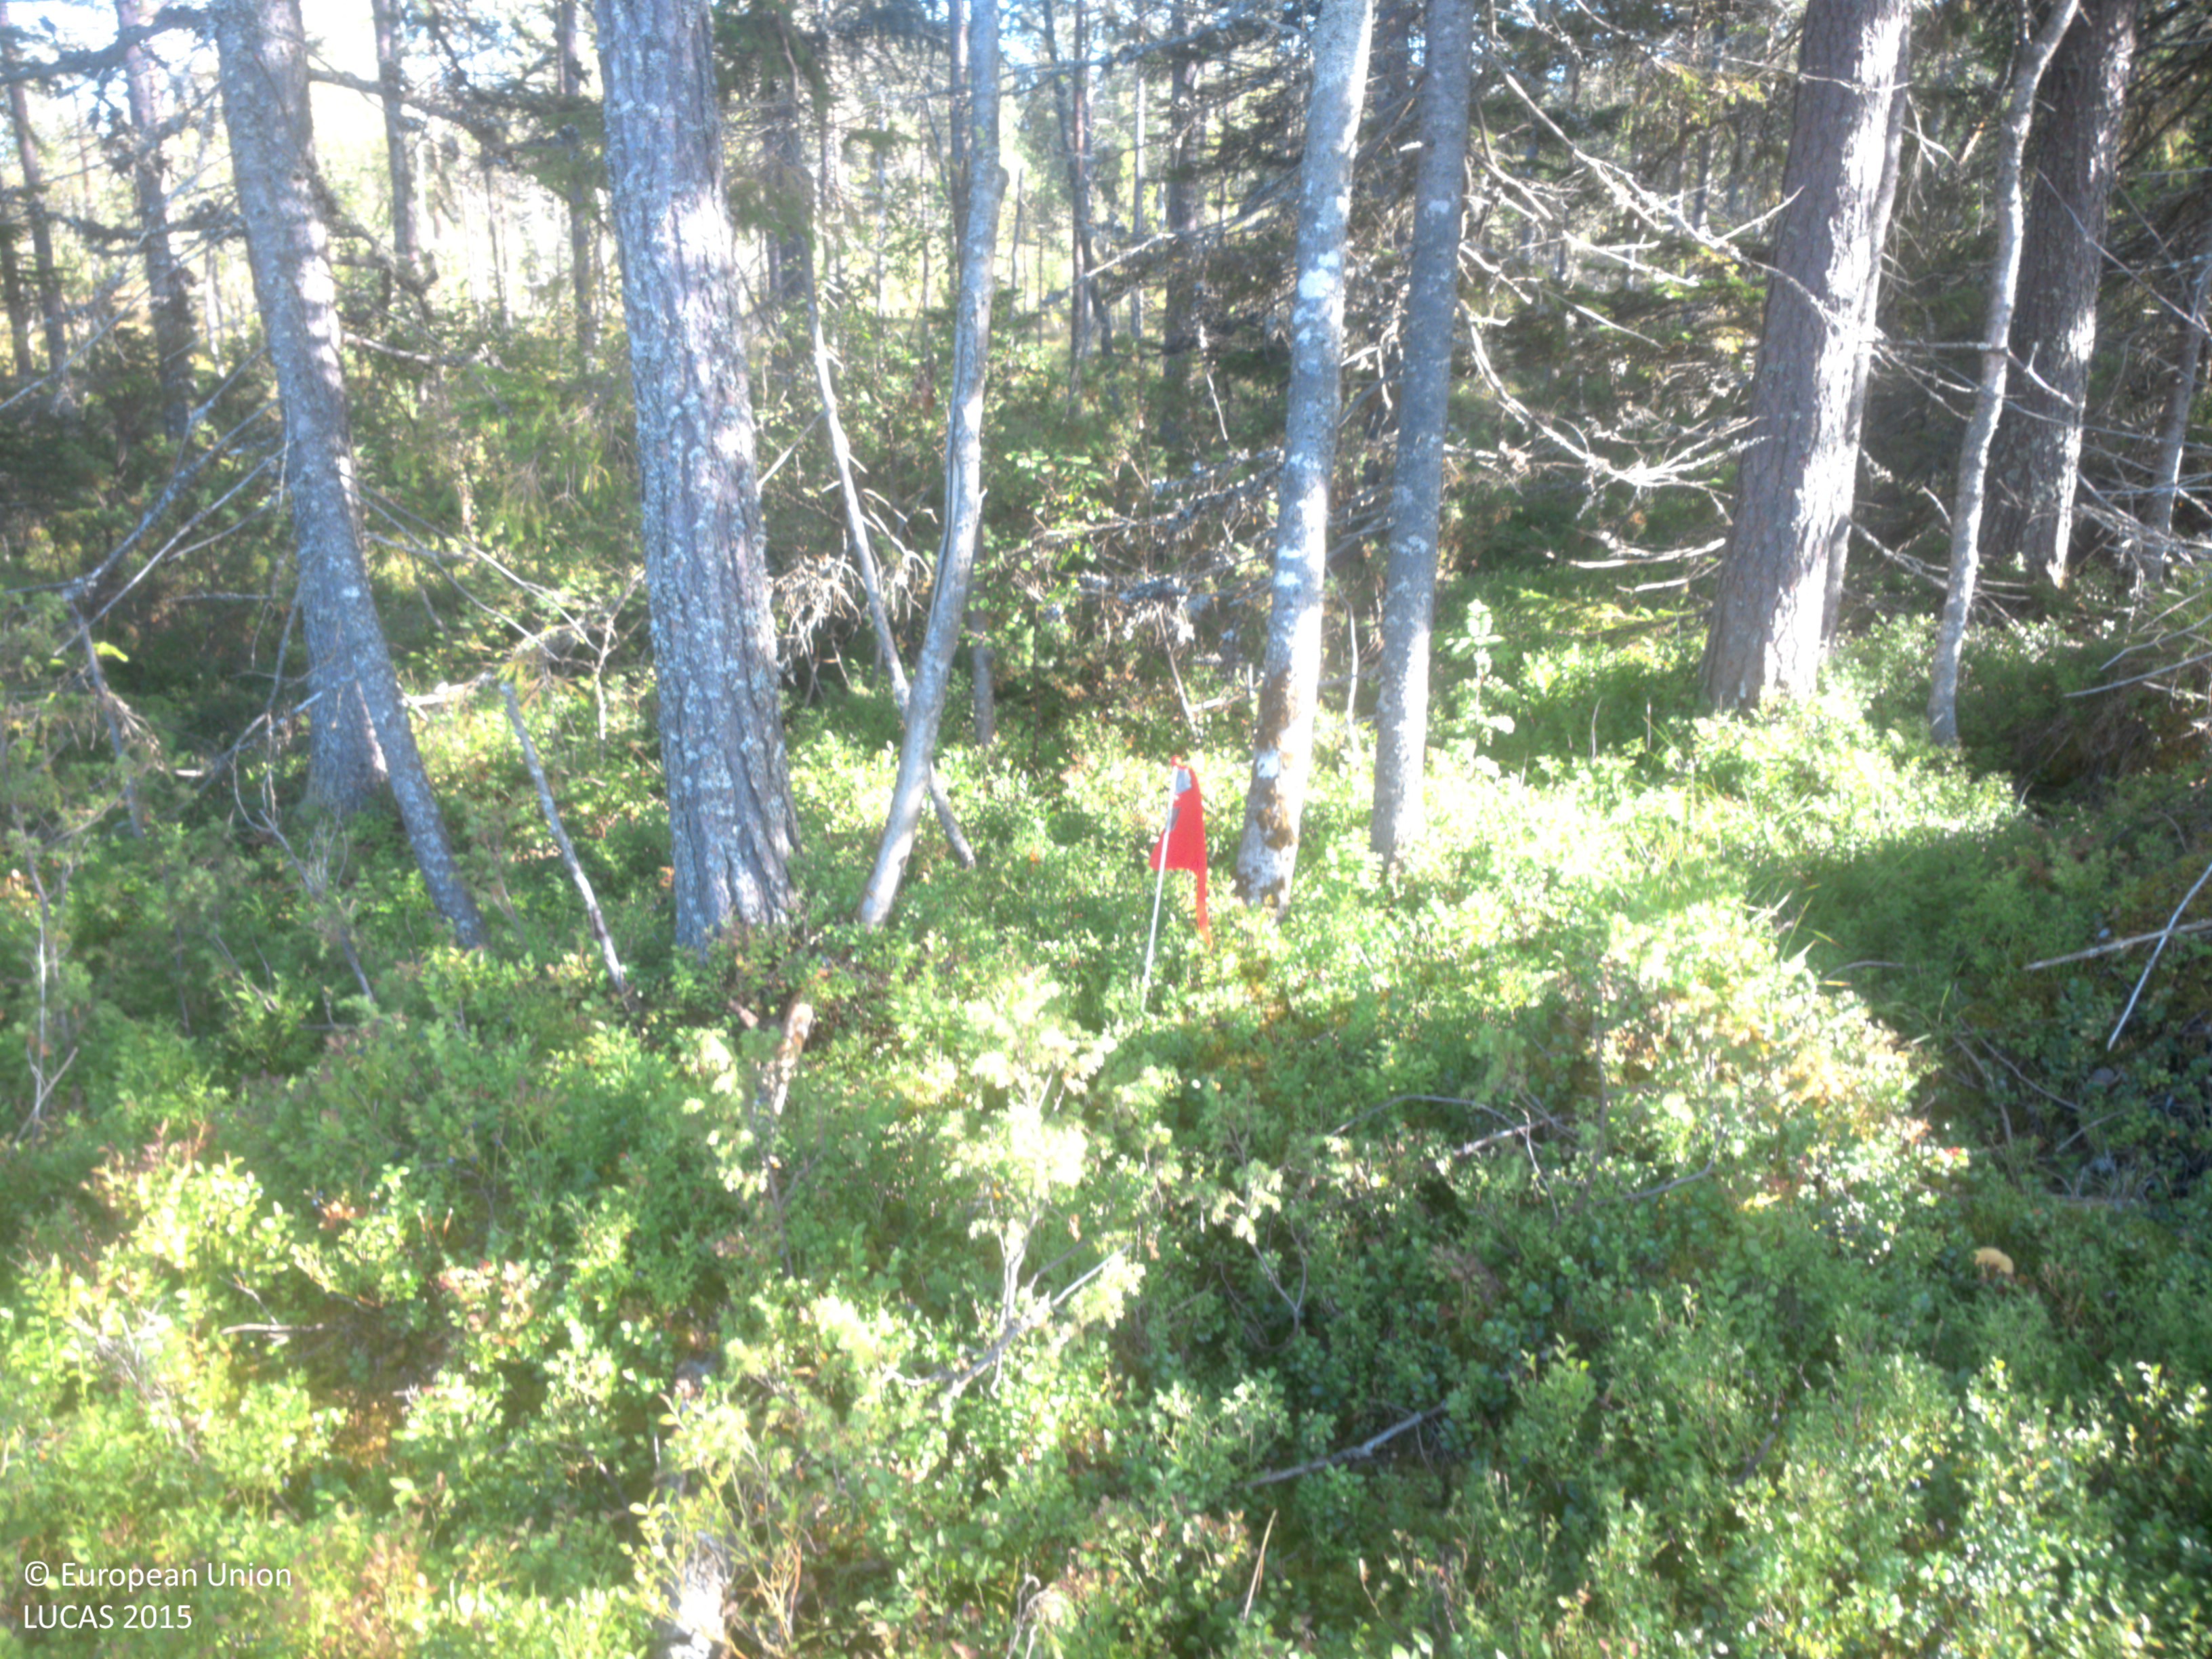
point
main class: Woodland
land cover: Other coniferous woodland
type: boreal forest
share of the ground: 50 - 75 %
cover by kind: coniferous forest trees 50 %, shrubs 50 %
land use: Forestry
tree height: > 5 m
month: August
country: SE
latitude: 63.7886
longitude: 20.0255
